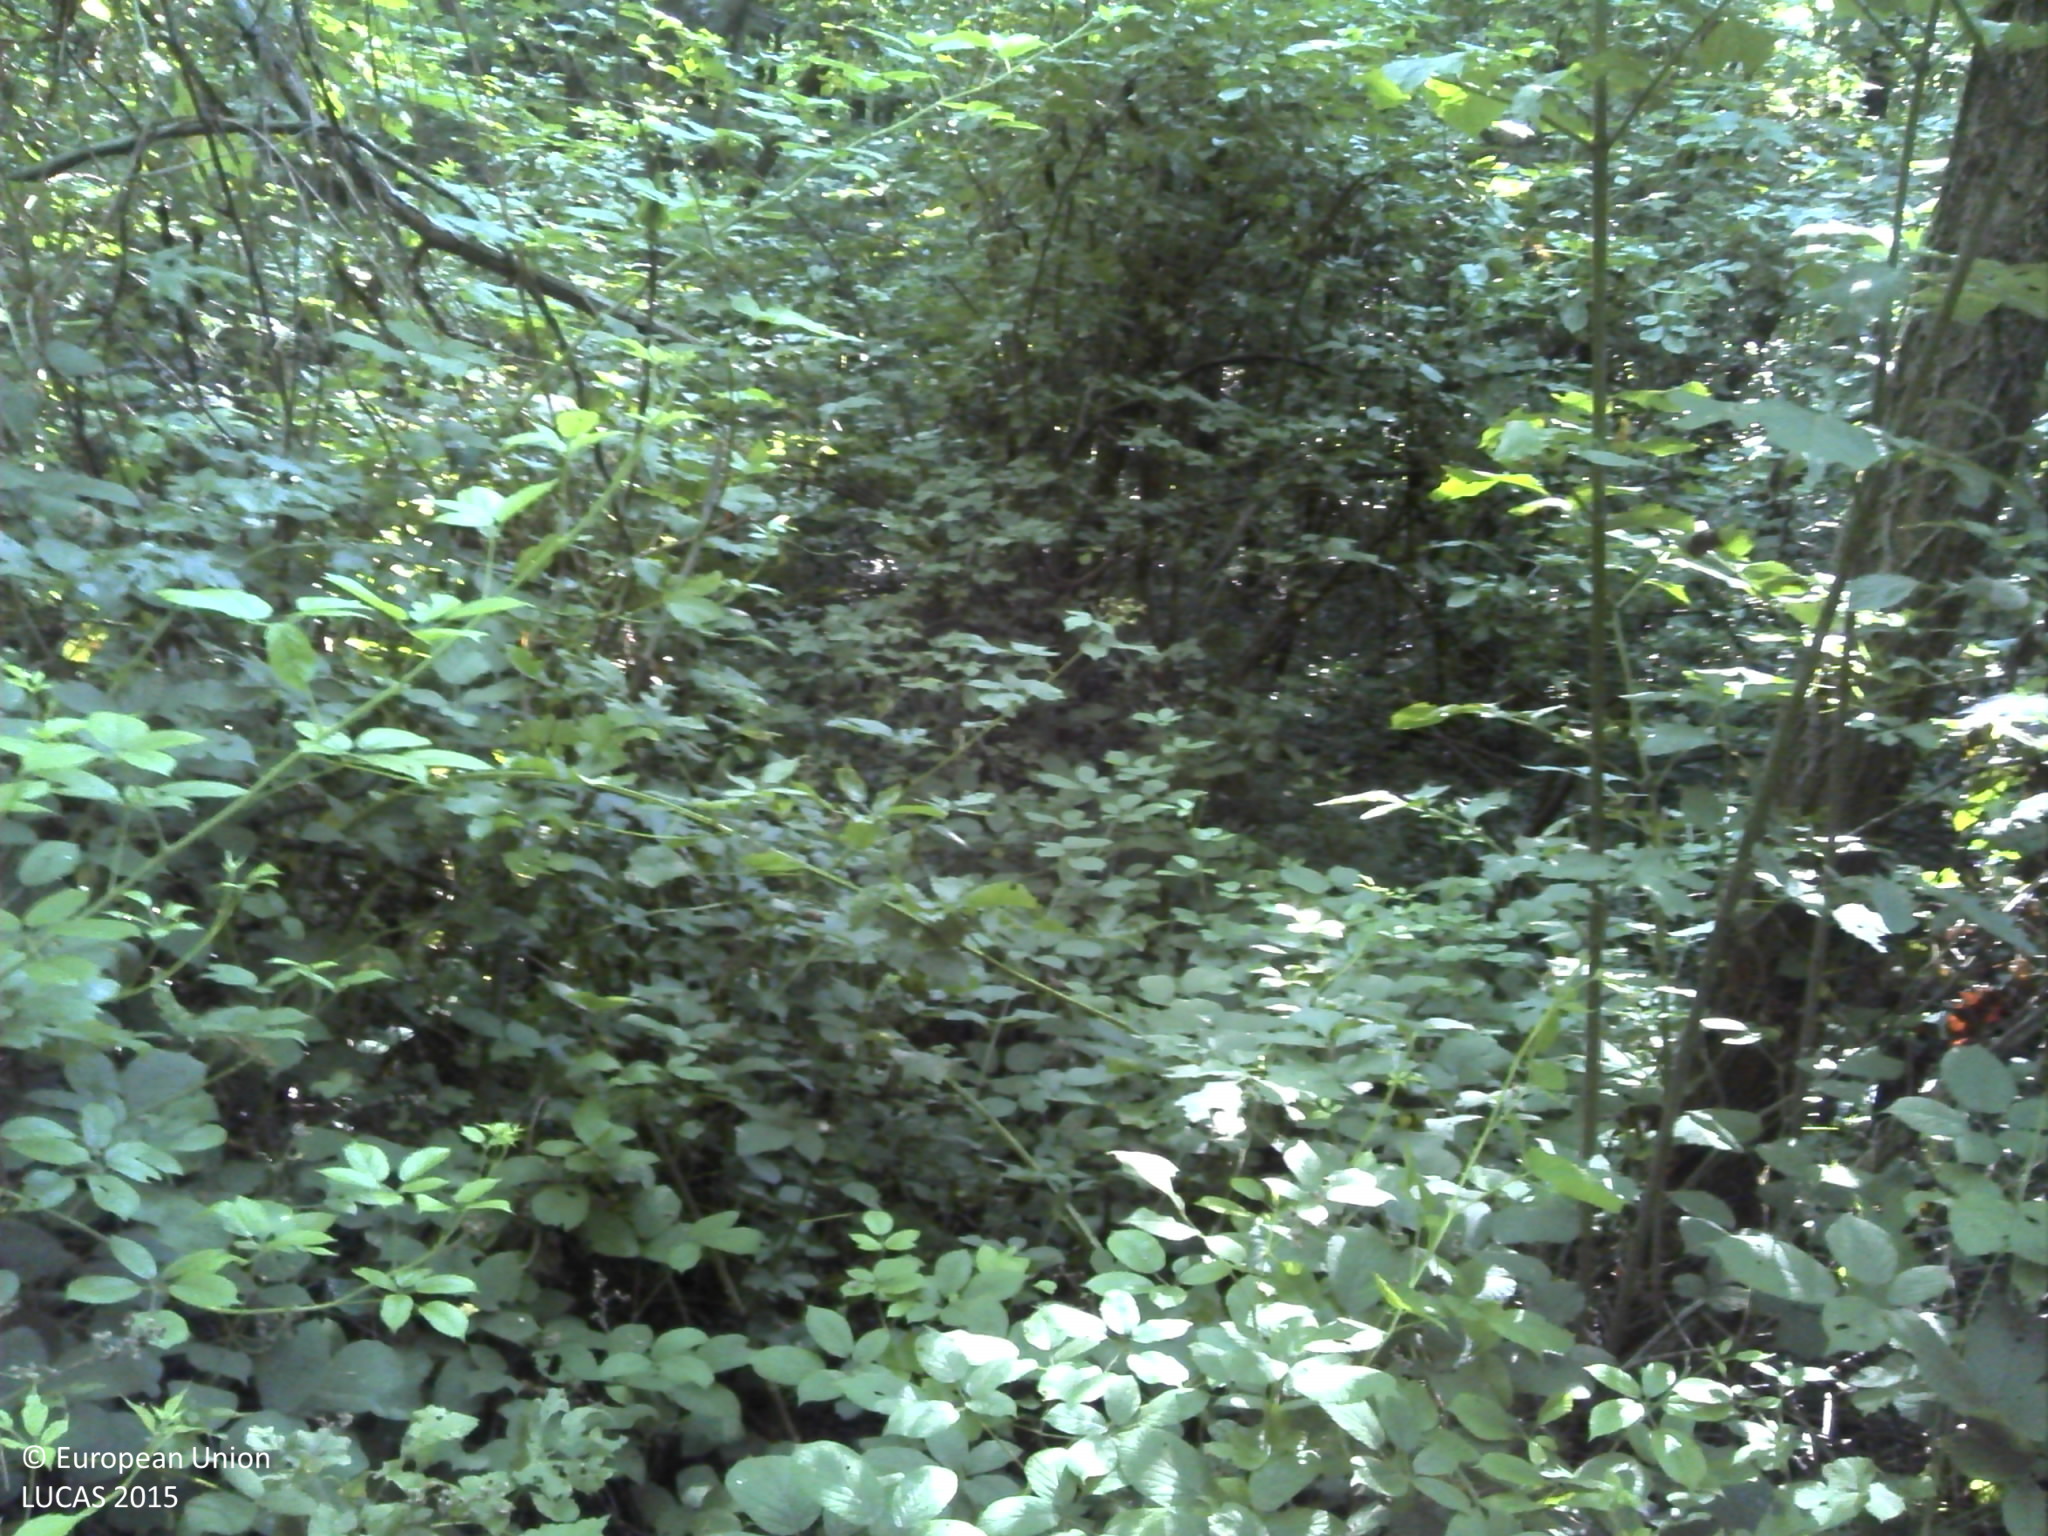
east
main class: Woodland
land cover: Broadleaved woodland
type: acidophilous oak and oak-birch forest
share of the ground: > 75 %
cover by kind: broadleaved forest trees 100 %
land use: Forestry
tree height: > 5 m
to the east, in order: Broadleaved woodland; Tracks; Broadleaved woodland; Ditches and canals; Broadleaved woodland
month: June
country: HR
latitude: 45.2802
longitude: 17.4070
